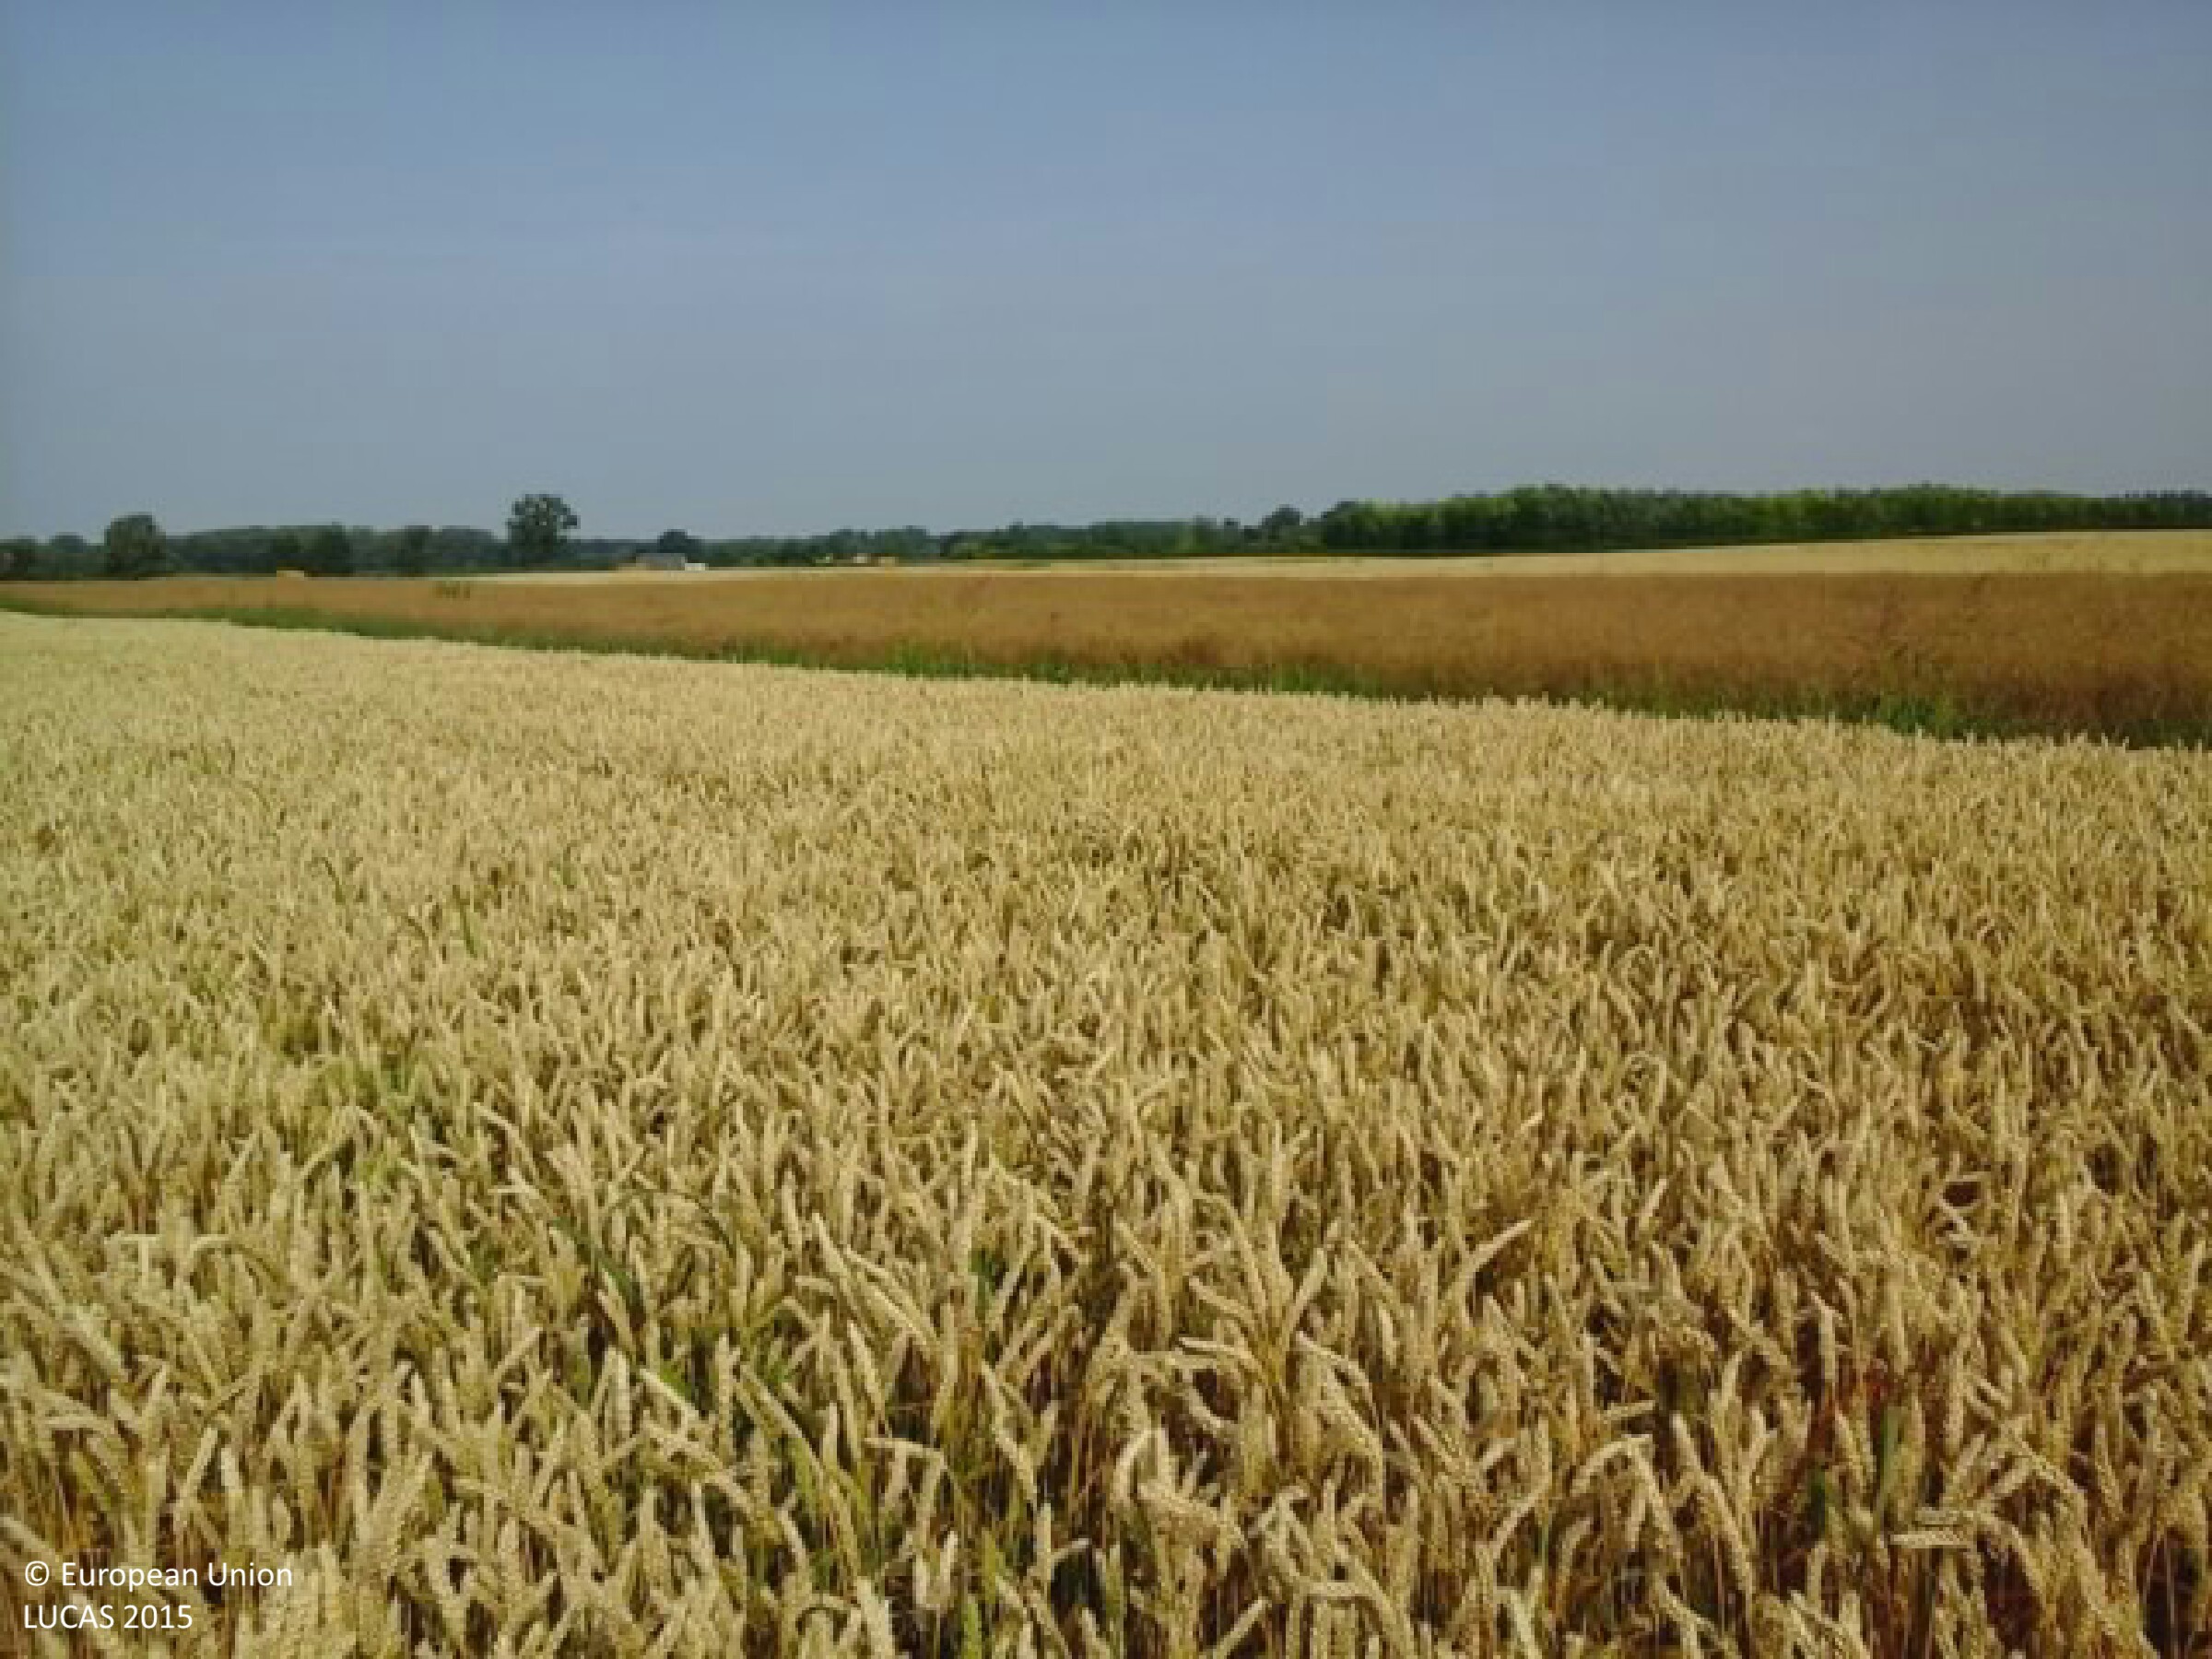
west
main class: Cropland
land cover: Common wheat
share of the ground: > 75 %
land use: Agriculture (excluding fallow land and kitchen gardens)
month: June
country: HU
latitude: 46.3723
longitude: 18.9698
